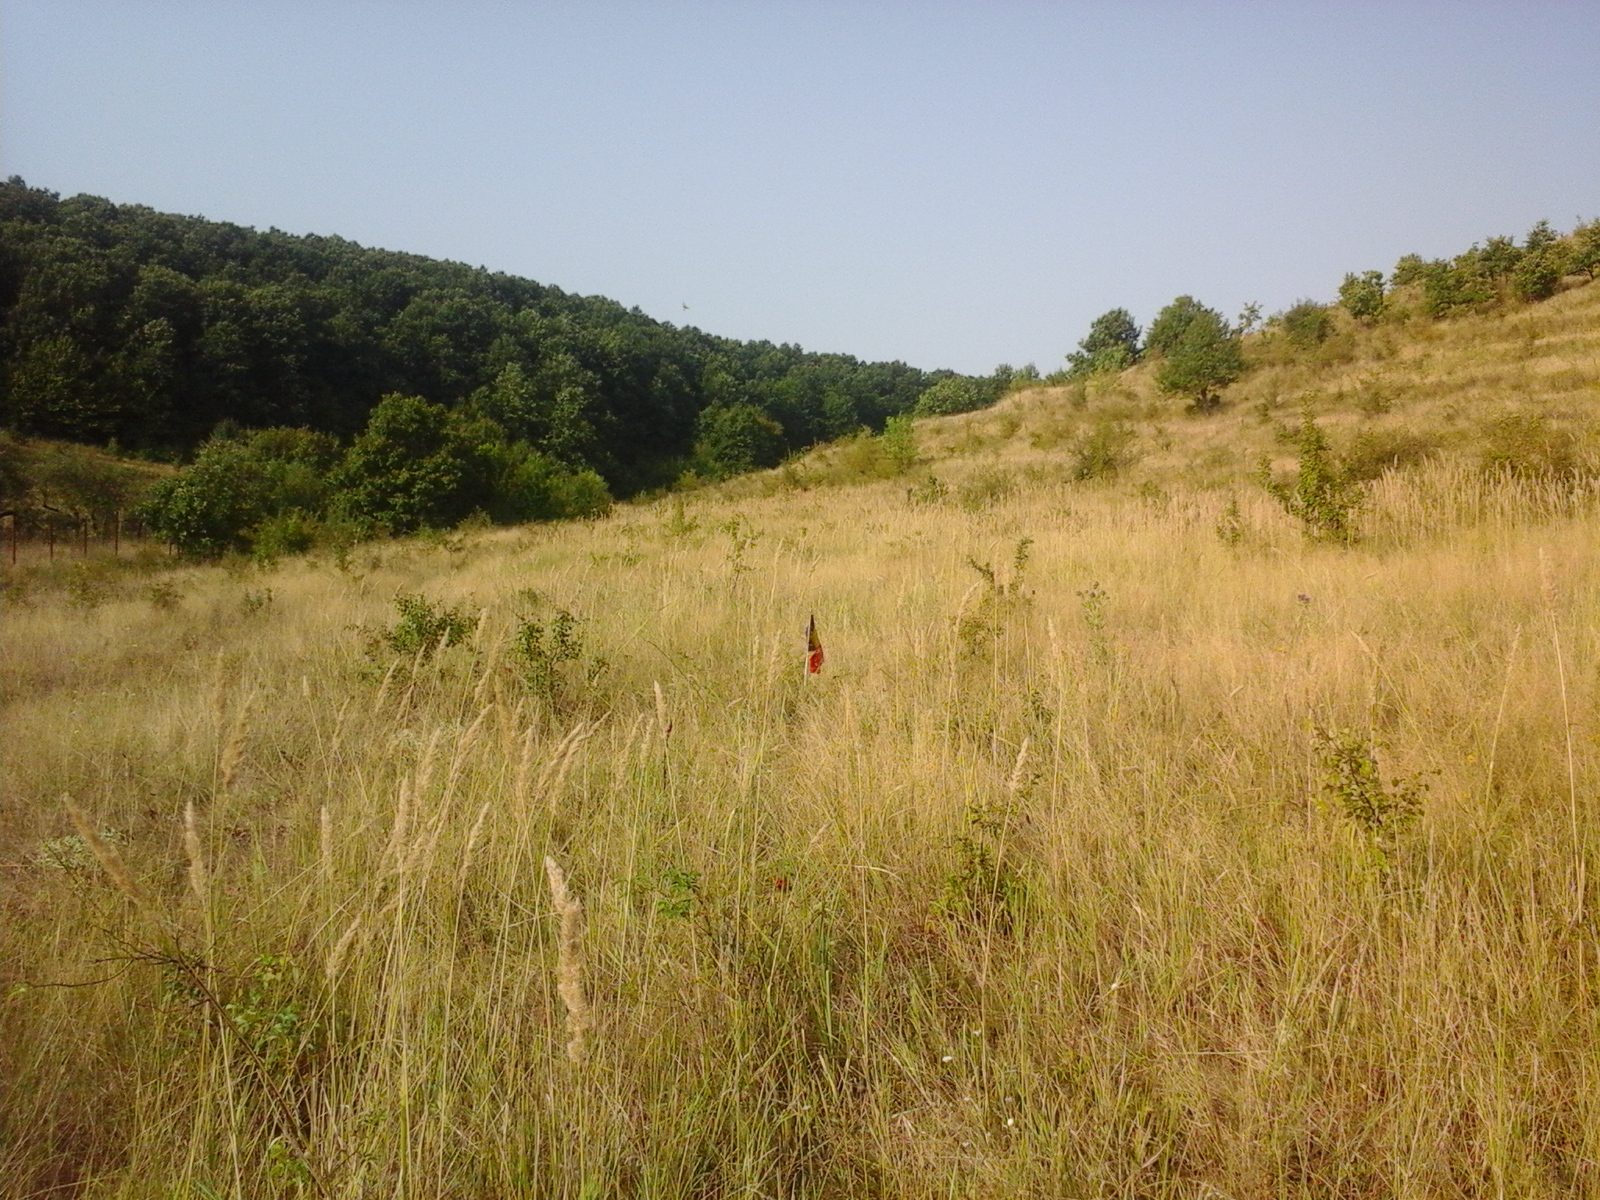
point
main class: Grassland
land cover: Grassland with sparse tree/shrub cover
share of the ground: > 75 %
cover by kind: herbaceous plants 90 %, broadleaved forest trees 5 %, shrubs 5 %
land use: Fallow land
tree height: < 5 m
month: August
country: RO
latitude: 44.5363
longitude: 23.8141
